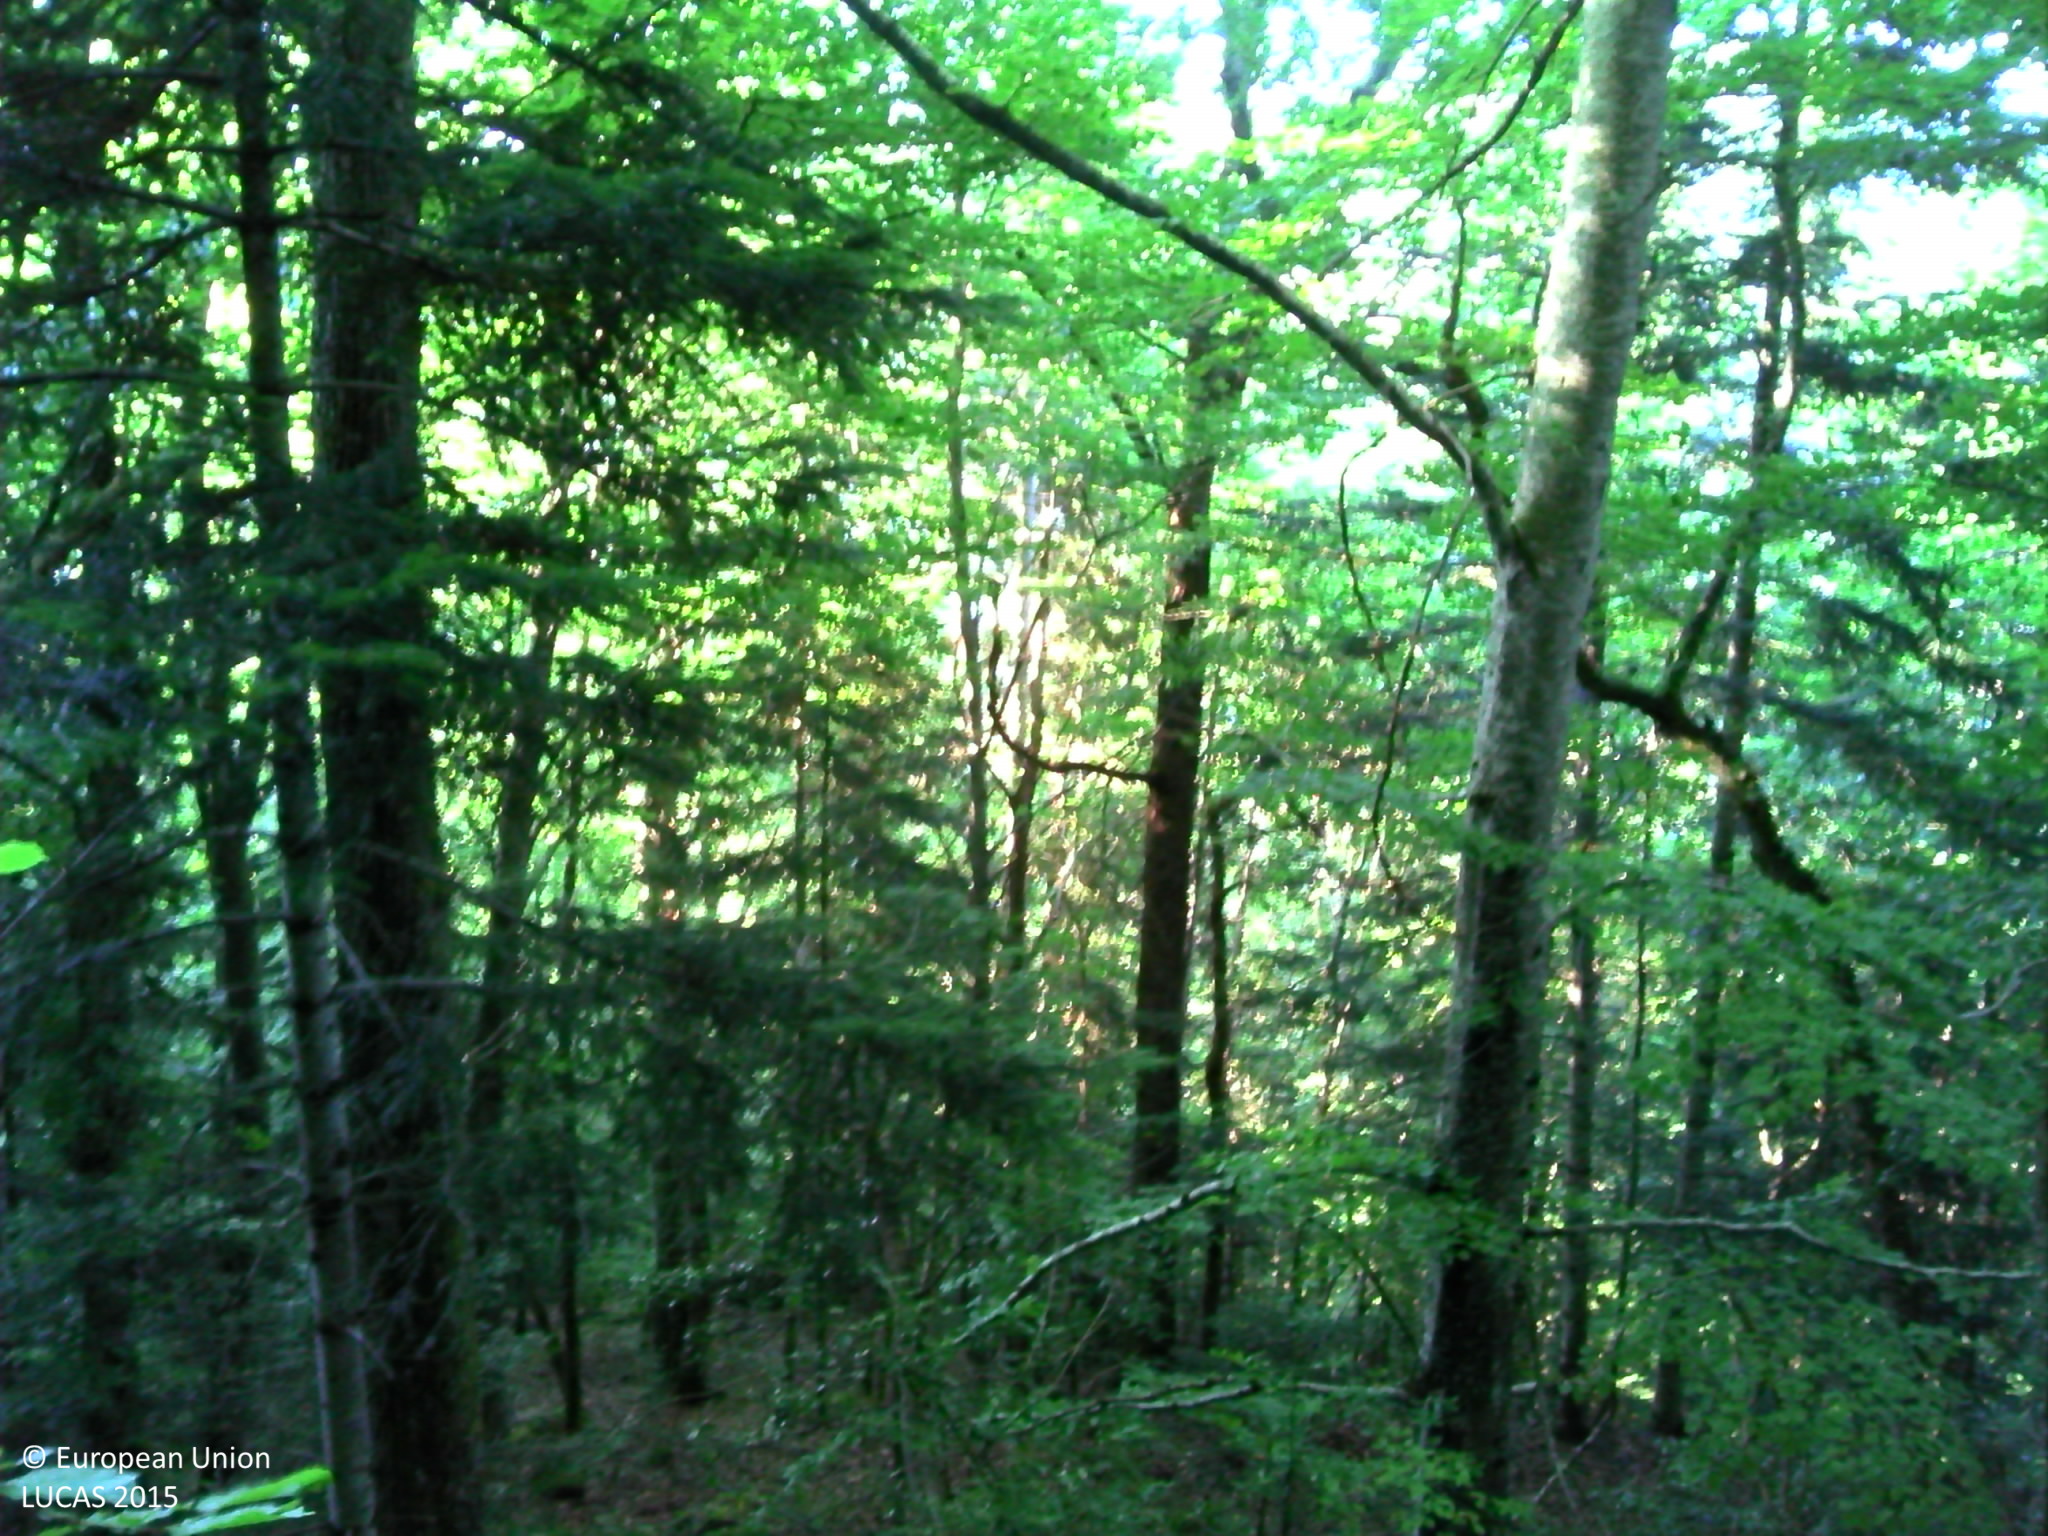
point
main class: Woodland
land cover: Spruce dominated mixed woodland
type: mountainous beech forest
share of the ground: > 75 %
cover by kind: broadleaved forest trees 60 %, coniferous forest trees 40 %
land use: Semi-natural and natural areas not in use
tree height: > 5 m
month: July
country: FR
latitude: 42.7214
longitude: 1.8150
